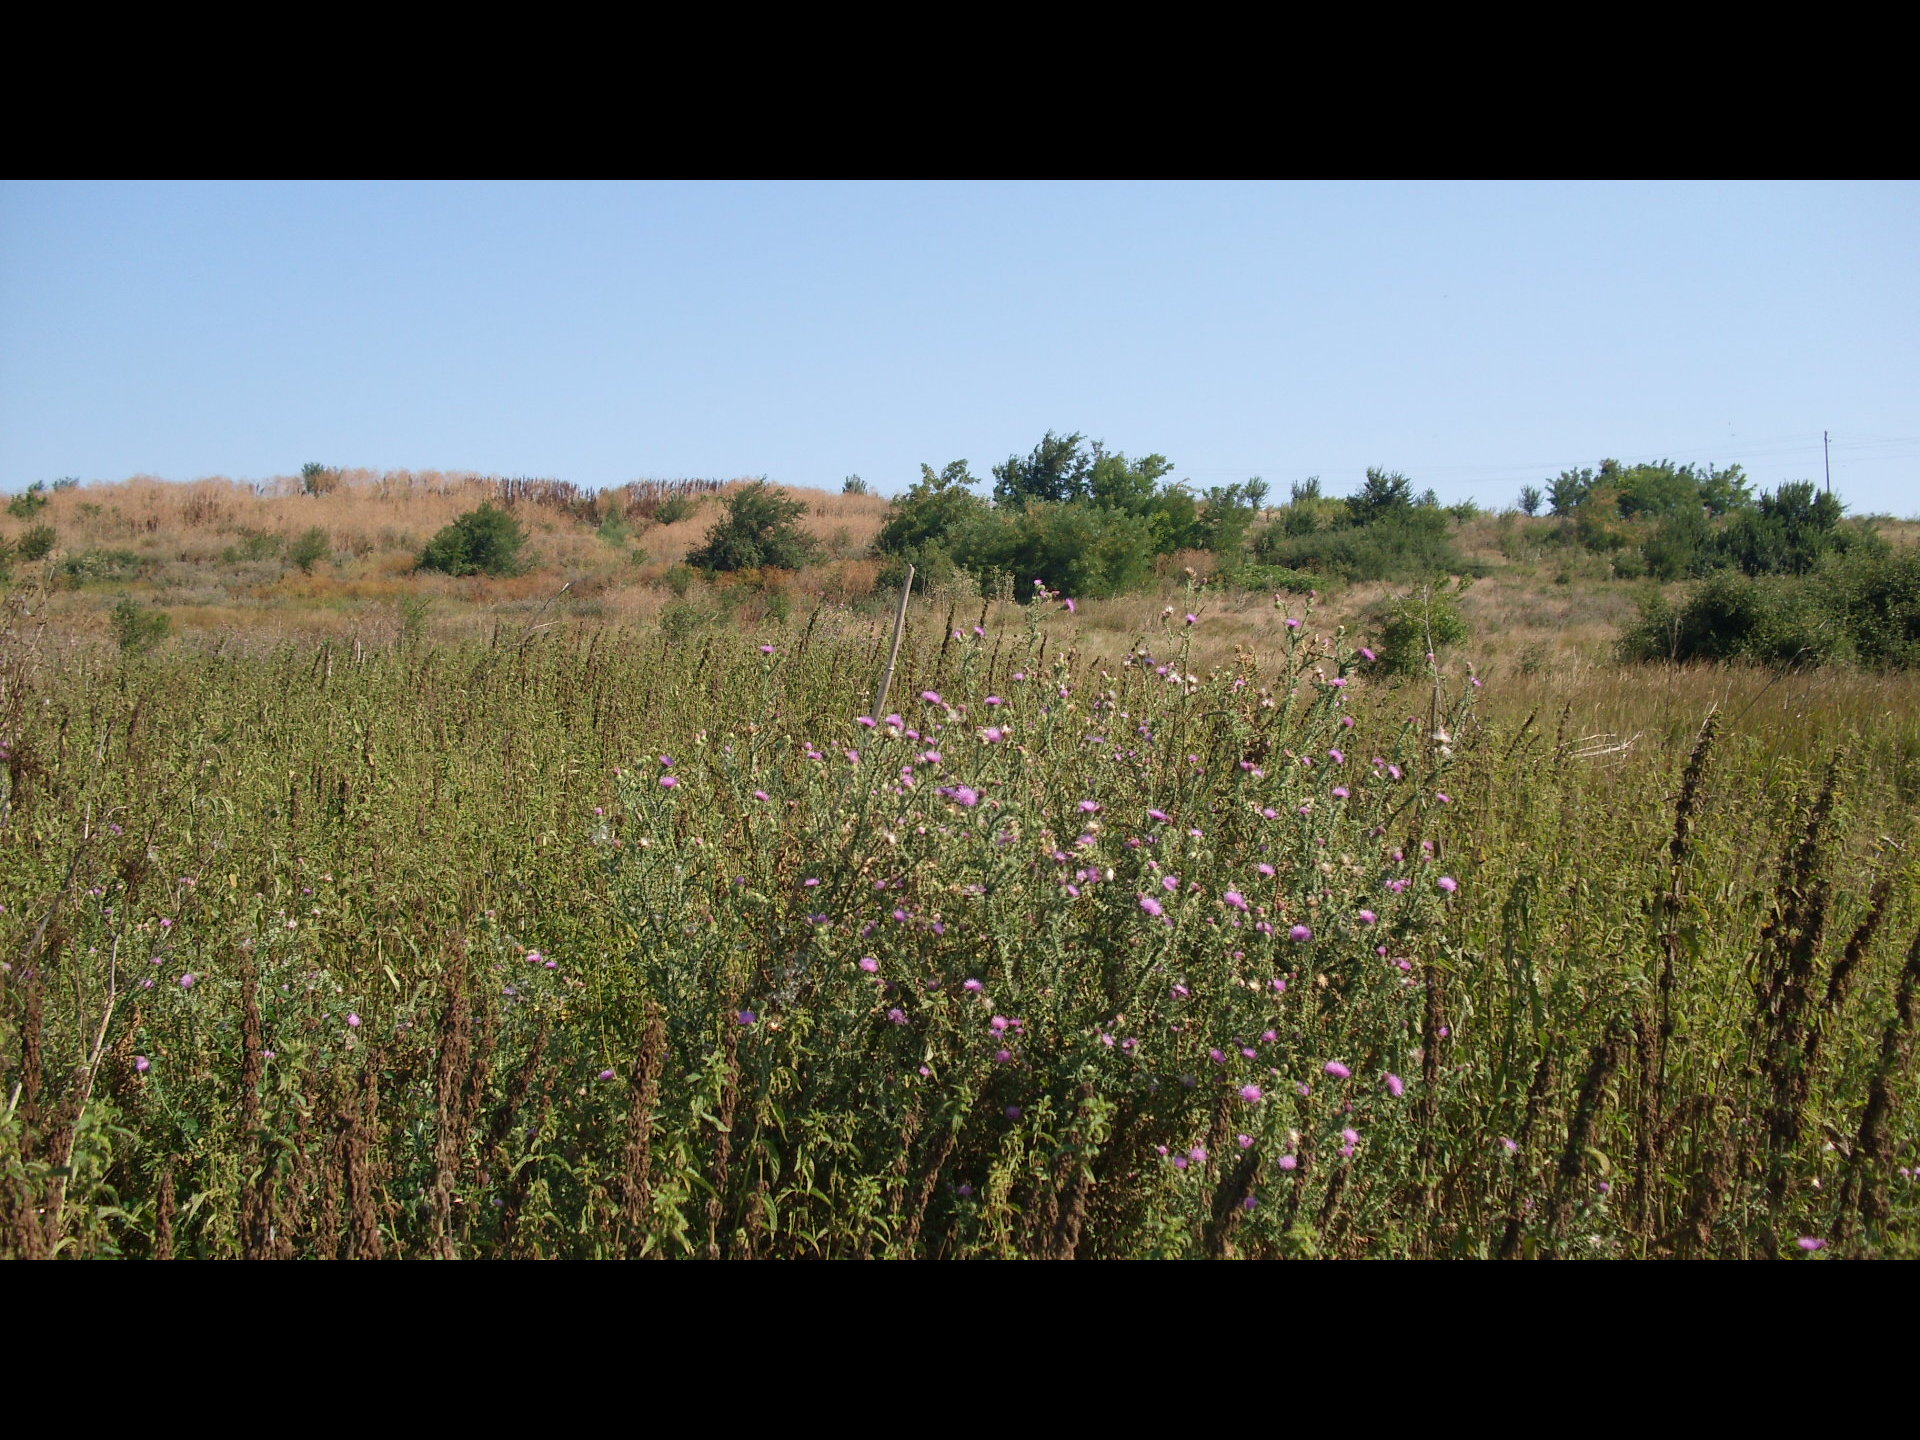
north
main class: Grassland
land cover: Grassland without tree/shrub cover
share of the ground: > 75 %
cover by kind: herbaceous plants 100 %
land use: Agriculture (excluding fallow land and kitchen gardens)
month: July
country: BG
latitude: 43.8305
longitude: 22.6320
